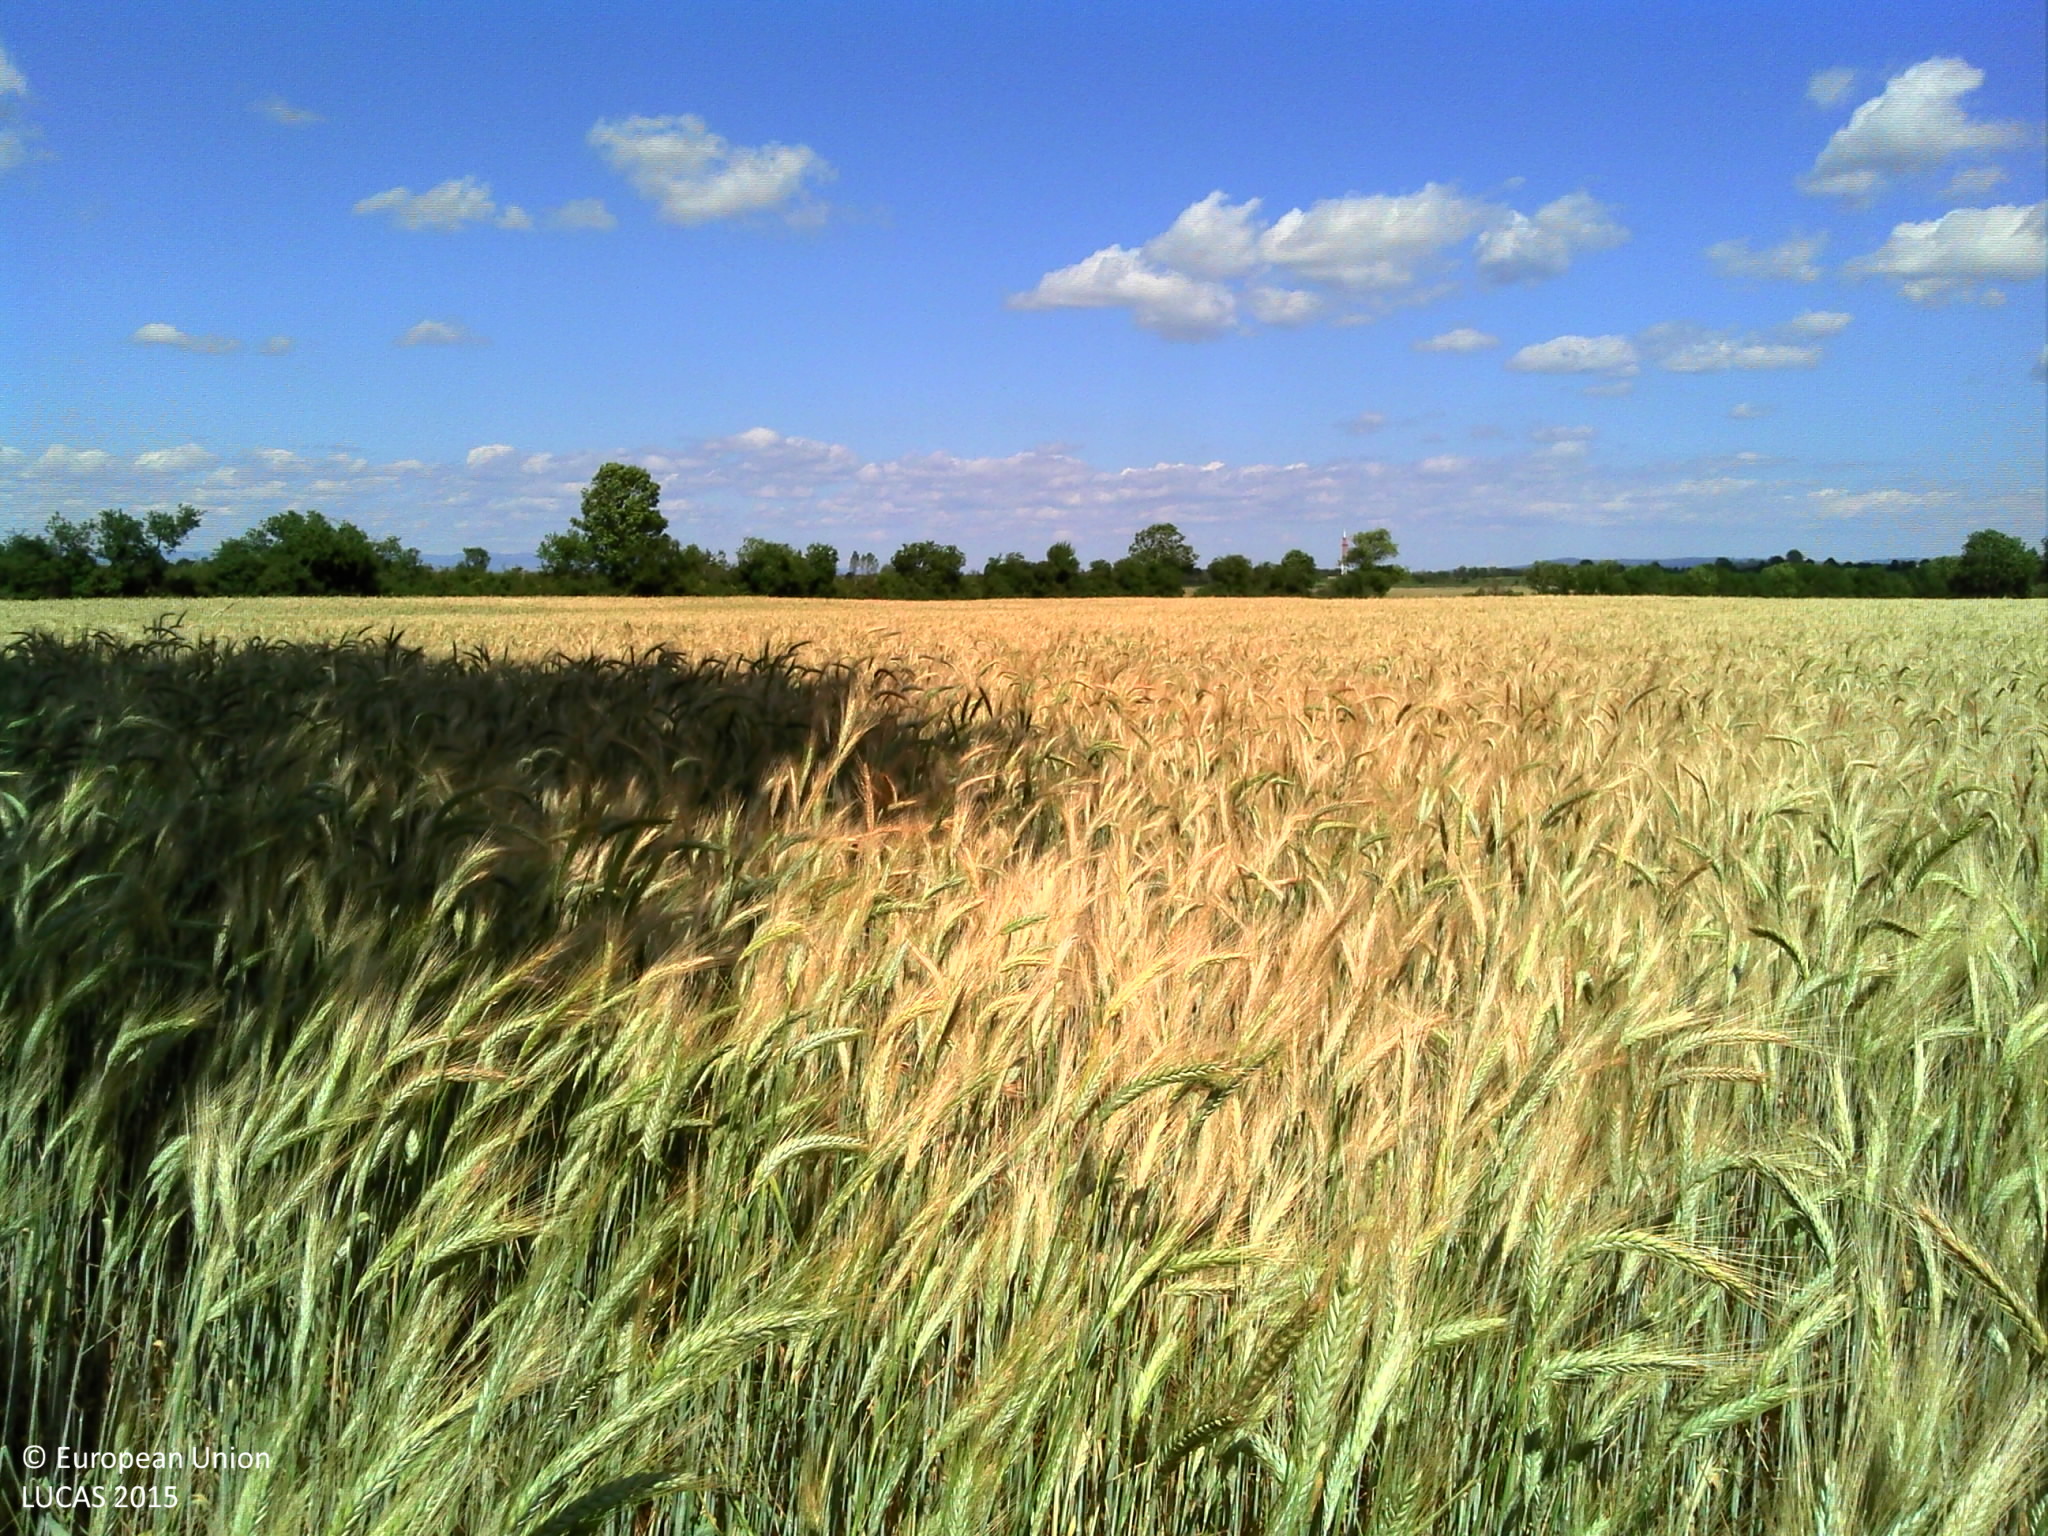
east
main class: Cropland
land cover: Triticale
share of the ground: > 75 %
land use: Agriculture (excluding fallow land and kitchen gardens)
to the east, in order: Triticale
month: June
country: FR
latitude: 44.4035
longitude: 2.4816
